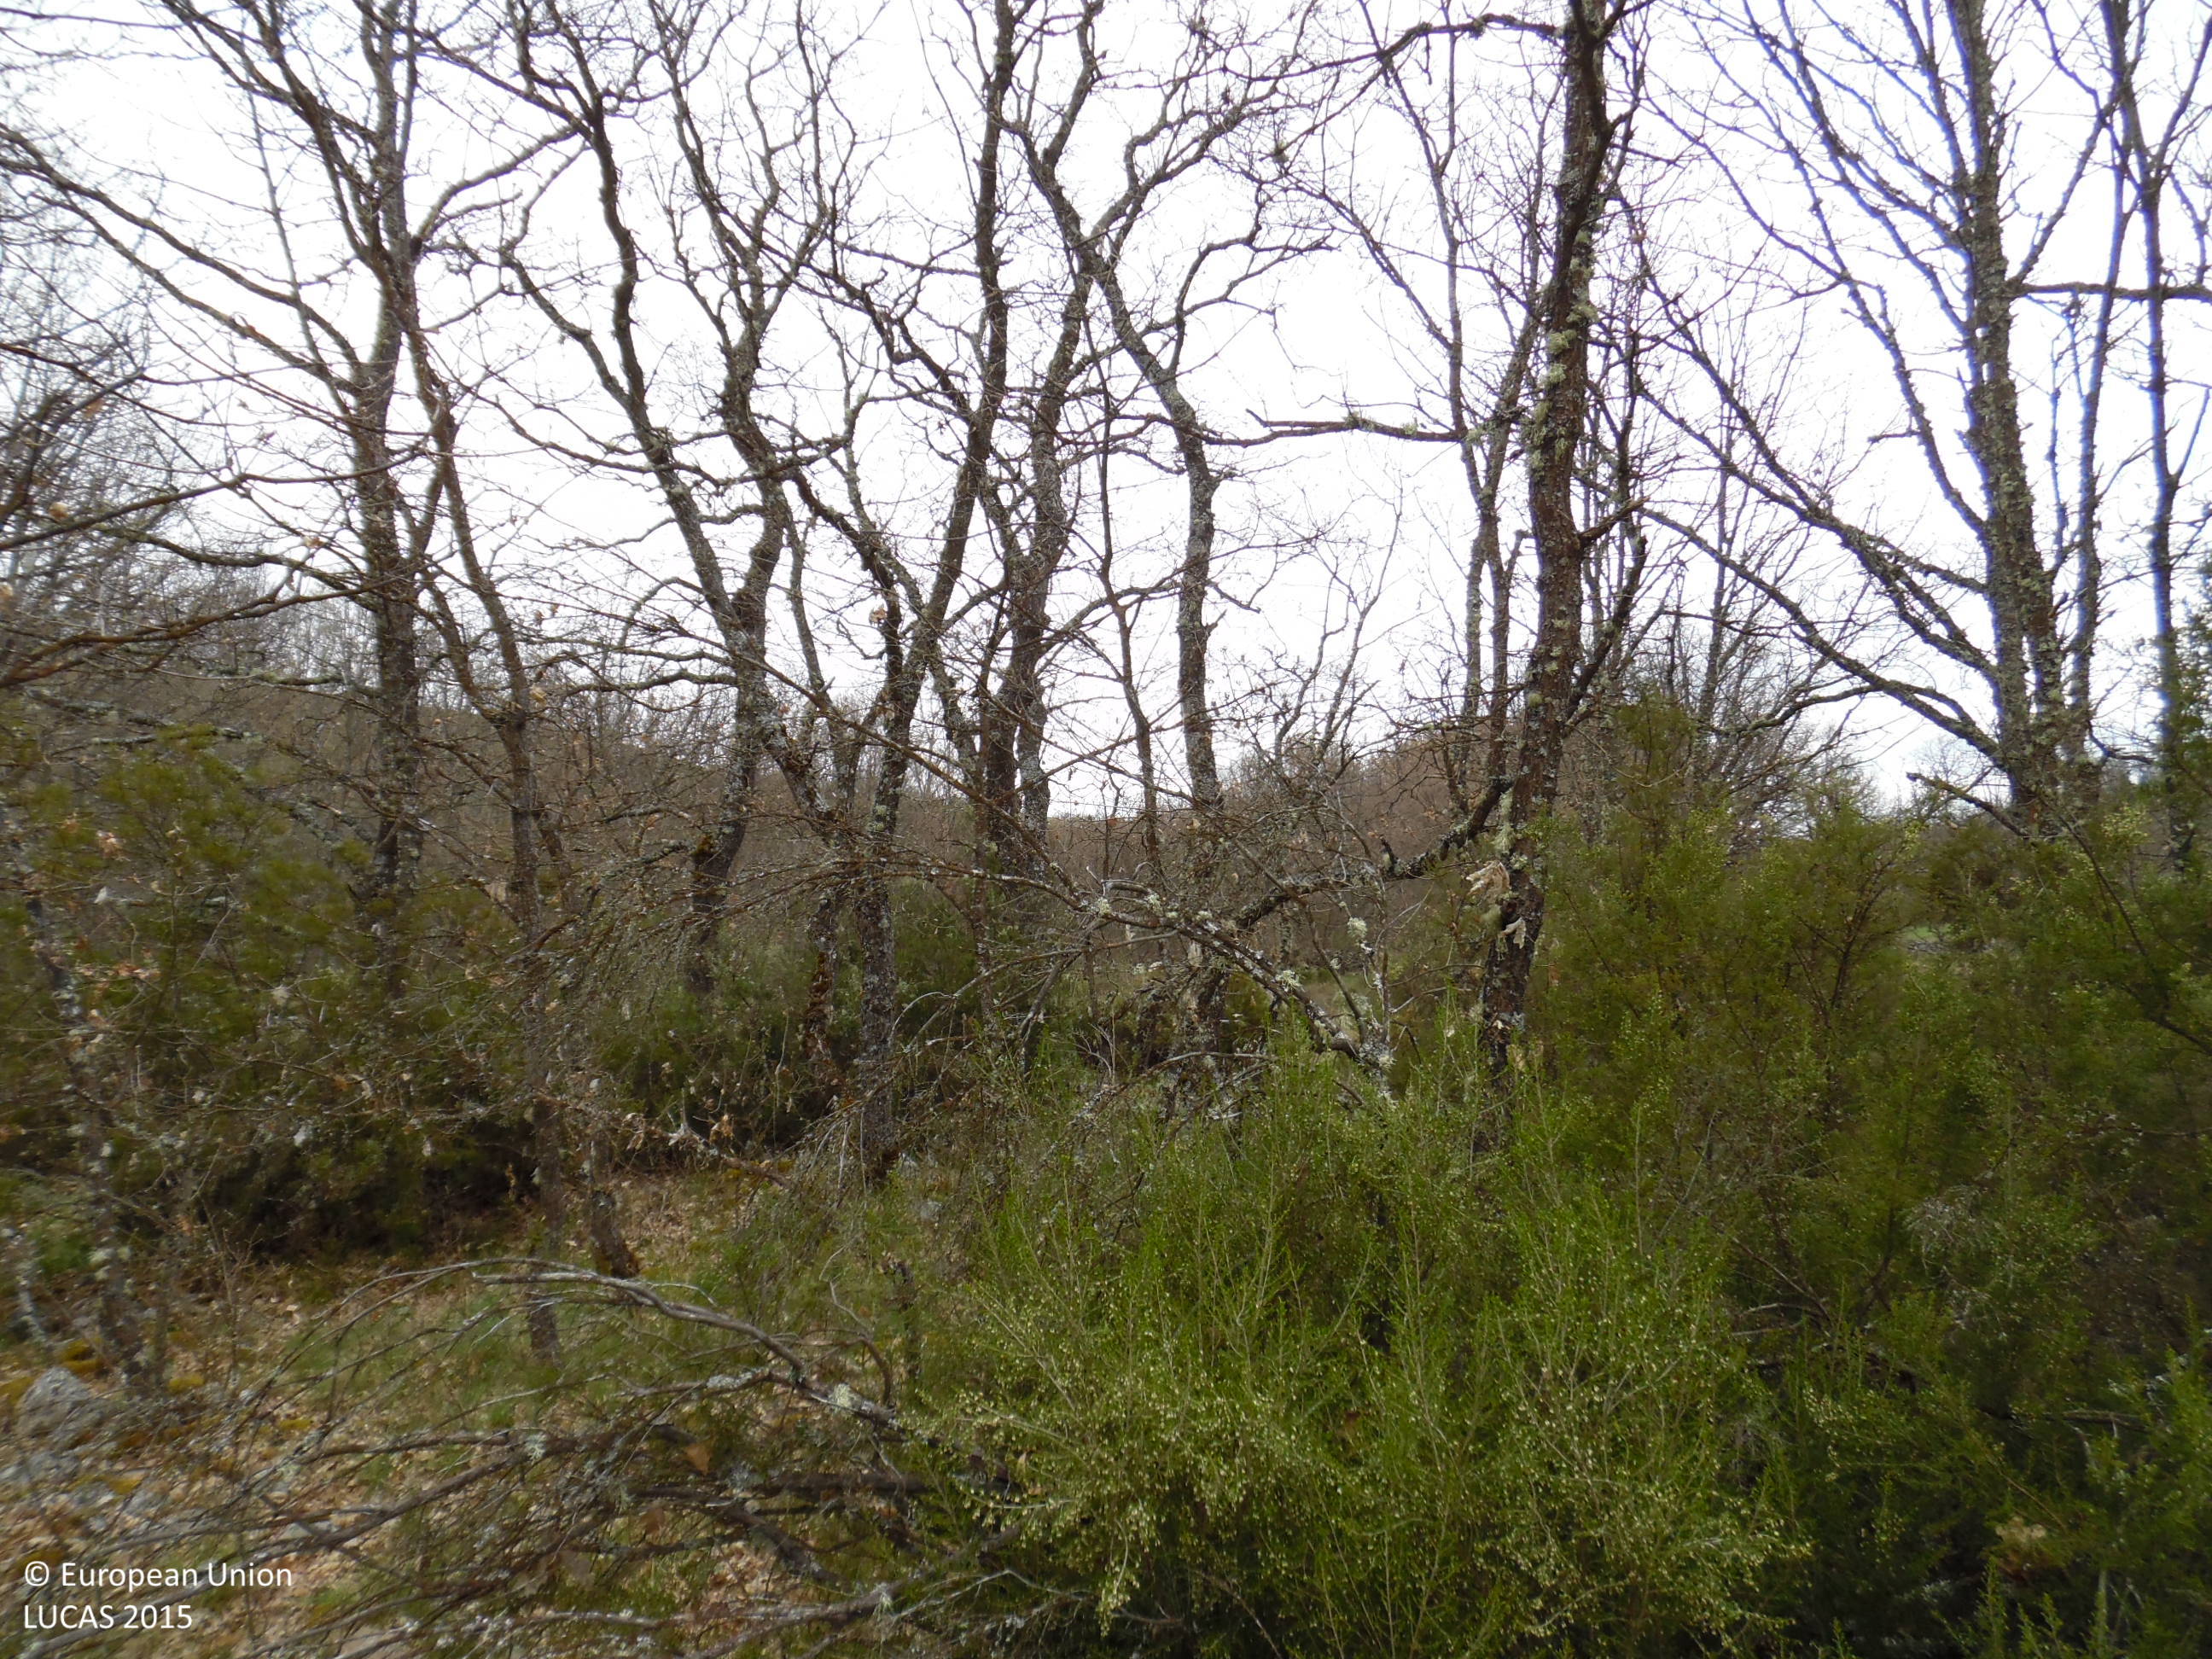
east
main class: Woodland
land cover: Broadleaved woodland
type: acidophilous oak and oak-birch forest
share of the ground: > 75 %
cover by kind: broadleaved forest trees 95 %, shrubs 5 %
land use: Forestry
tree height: > 5 m
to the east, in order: Broadleaved woodland; Tracks; Grassland with sparse tree/shrub cover; Grassland without tree/shrub cover; Broadleaved woodland; Dry stone walls; Ditches and canals; Grass margins; Broadleaved woodland; Grassland without tree/shrub cover; Groves; Inland fresh running water; Groves; Grassland without tree/shrub cover; Groves; Ditches and canals; Shrubland with sparse tree cover
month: April
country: ES
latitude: 42.3853
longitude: -6.3264
